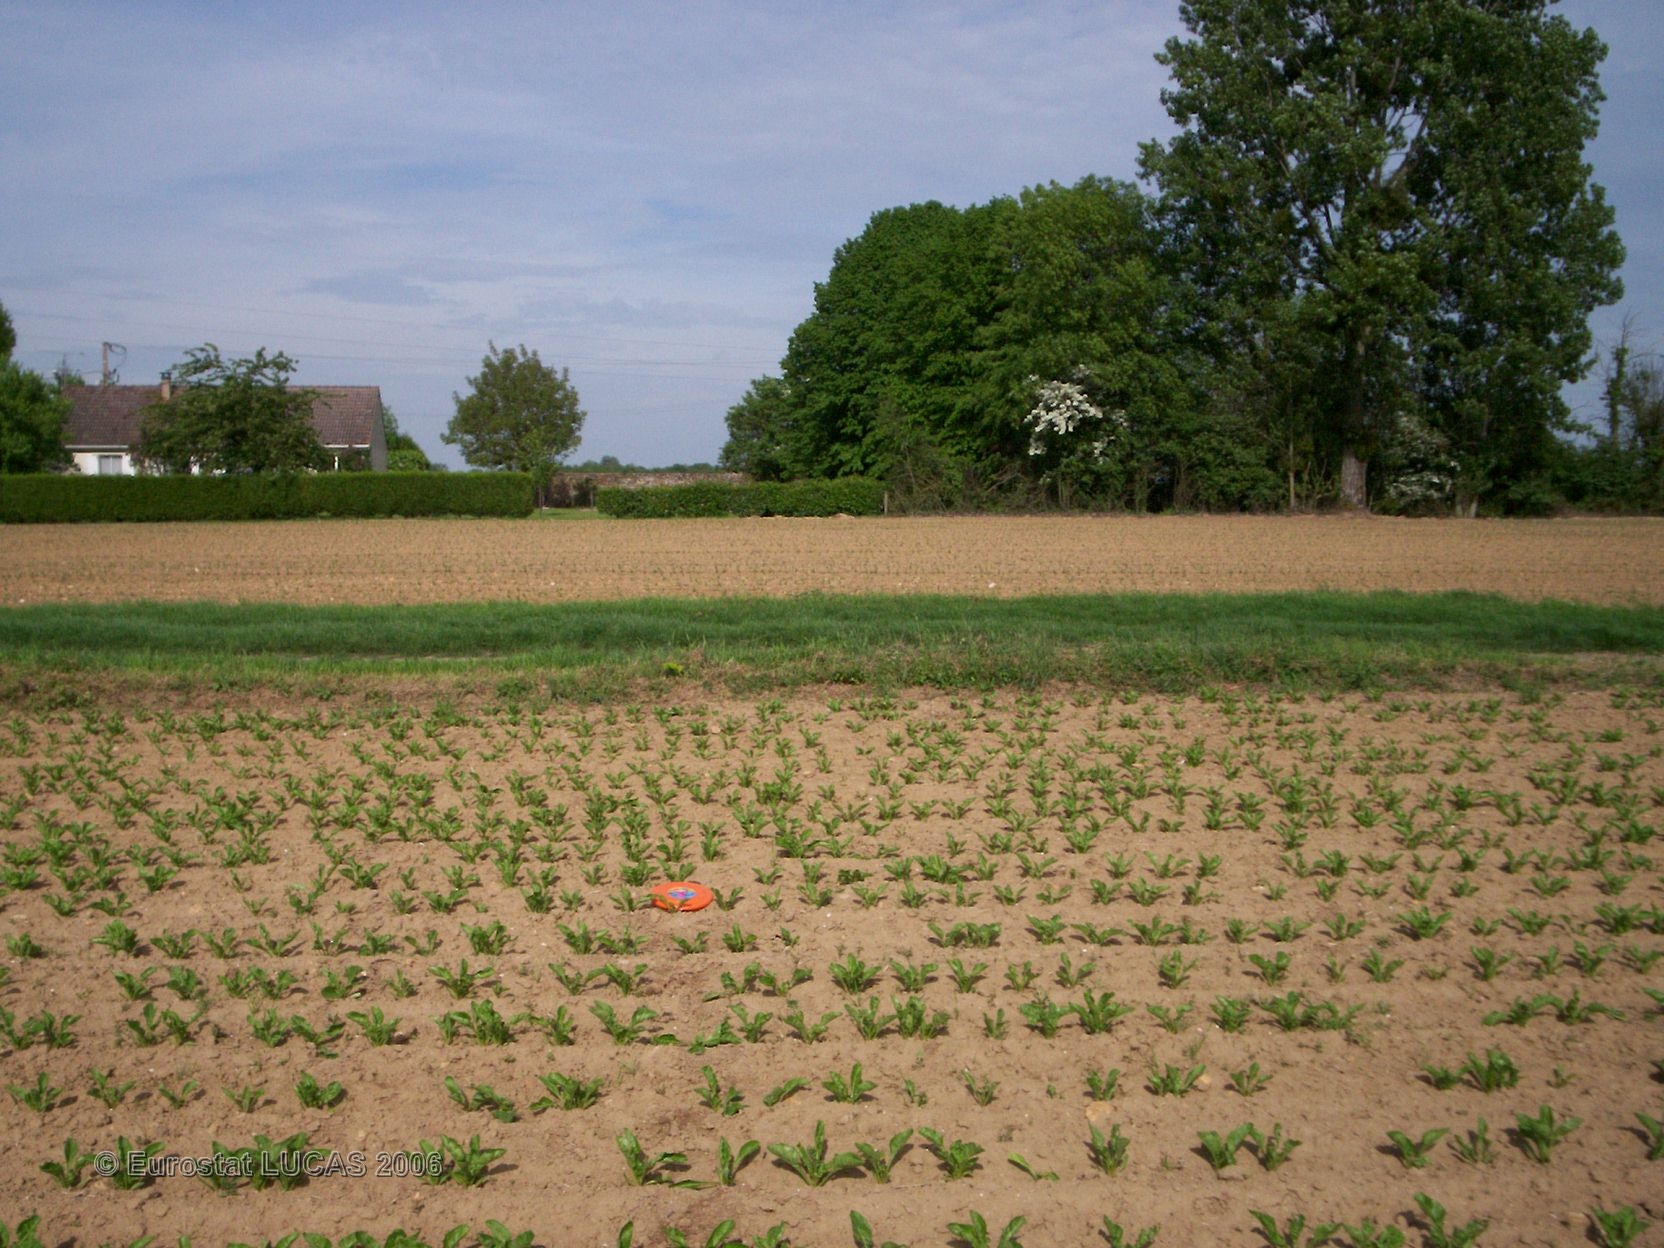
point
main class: Cropland
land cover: Sugar beet
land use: Agriculture (excluding fallow land and kitchen gardens)
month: May
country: FR
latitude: 48.6425
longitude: 2.8658
